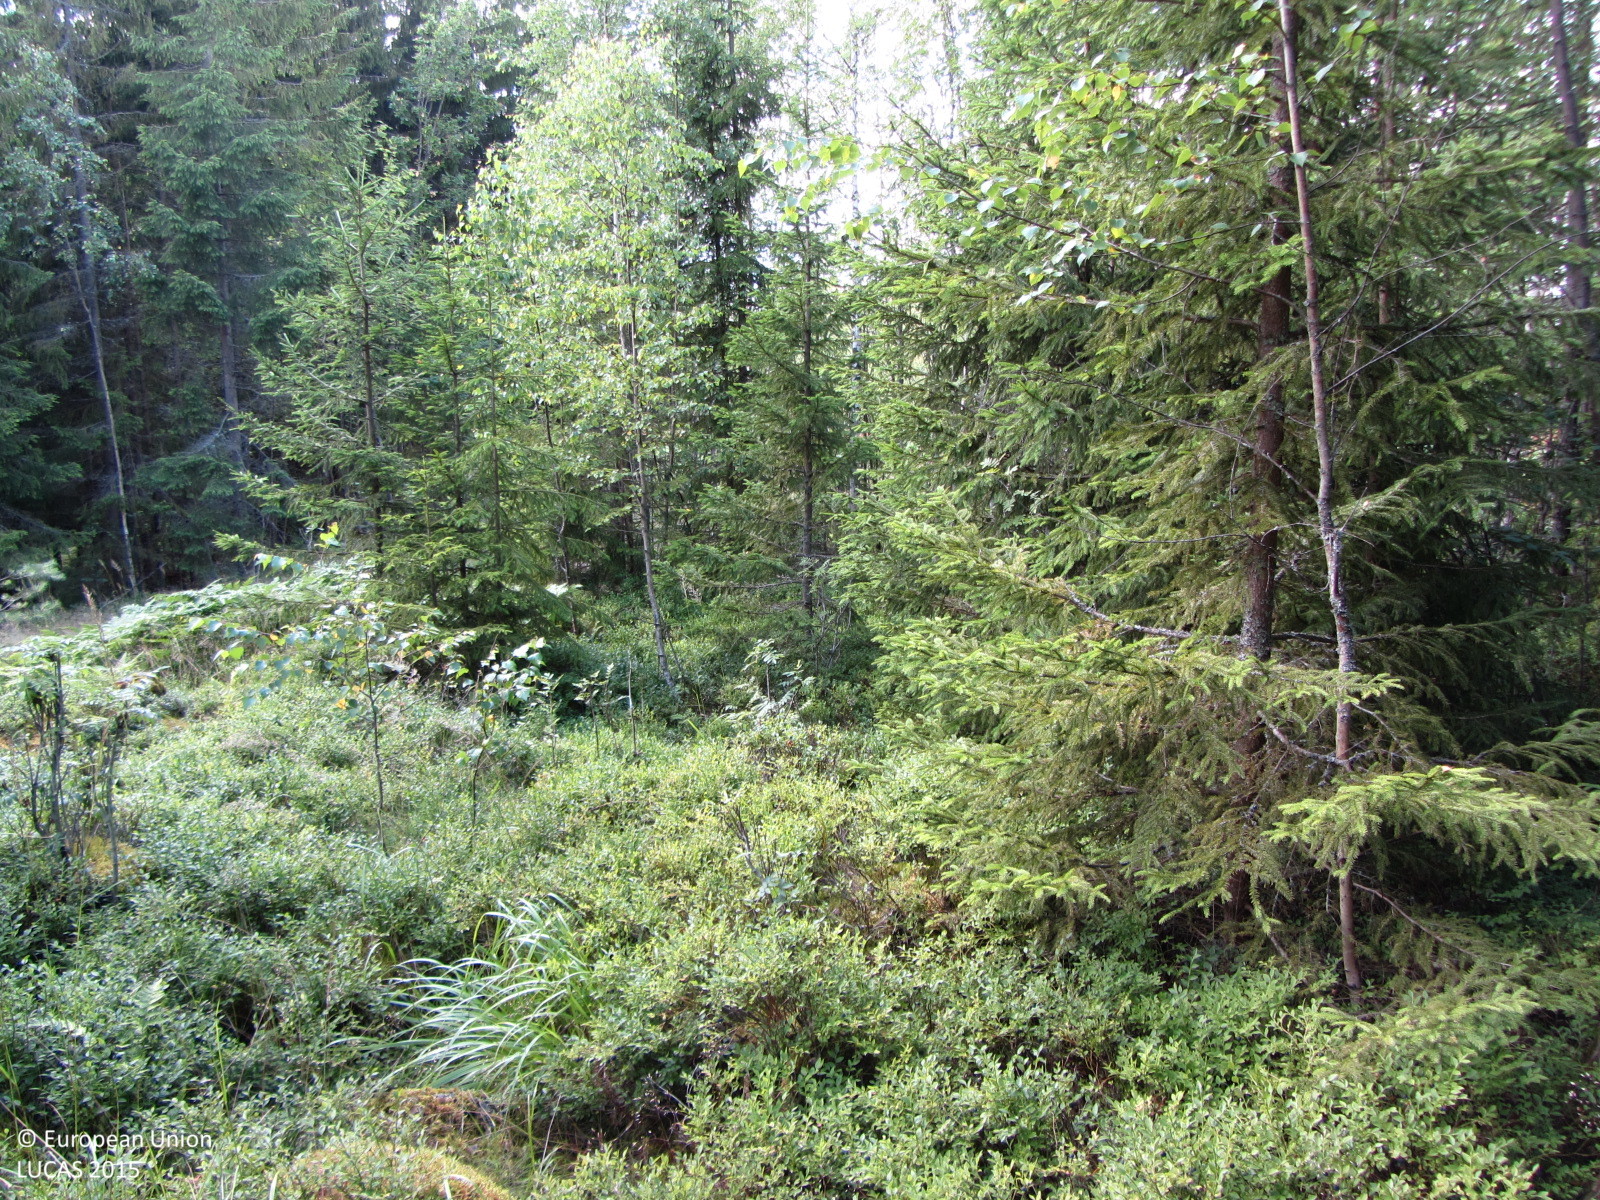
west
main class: Woodland
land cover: Spruce dominated mixed woodland
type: hemiboreal forest and nemoral coniferous forest and mixed broadleaved-coniferous forest
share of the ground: 50 - 75 %
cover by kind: coniferous forest trees 35 %, shrubs 25 %, broadleaved forest trees 20 %, herbaceous plants 20 %
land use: Forestry
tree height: > 5 m
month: July
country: FI
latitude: 60.1980
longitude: 24.4845
